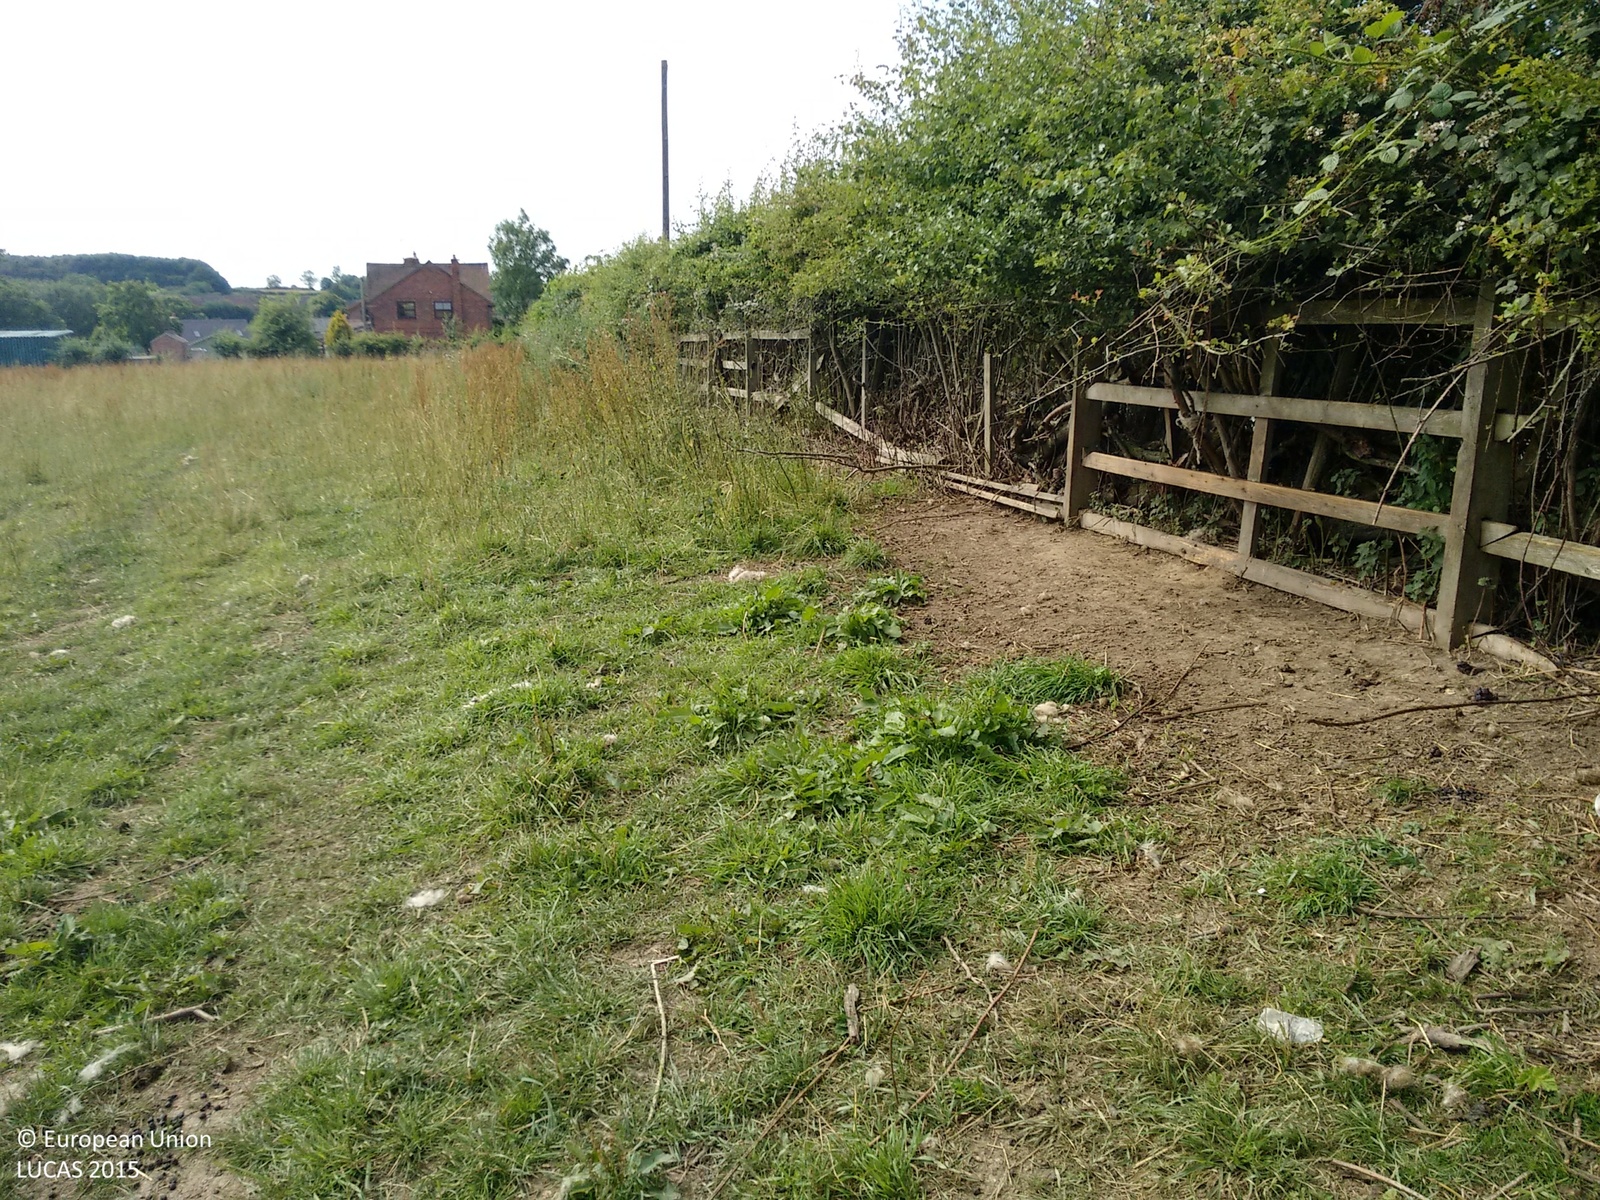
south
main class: Grassland
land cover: Grassland without tree/shrub cover
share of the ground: > 75 %
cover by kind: herbaceous plants 100 %
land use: Agriculture (excluding fallow land and kitchen gardens)
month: July
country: GB
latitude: 53.0227
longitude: -1.4246
